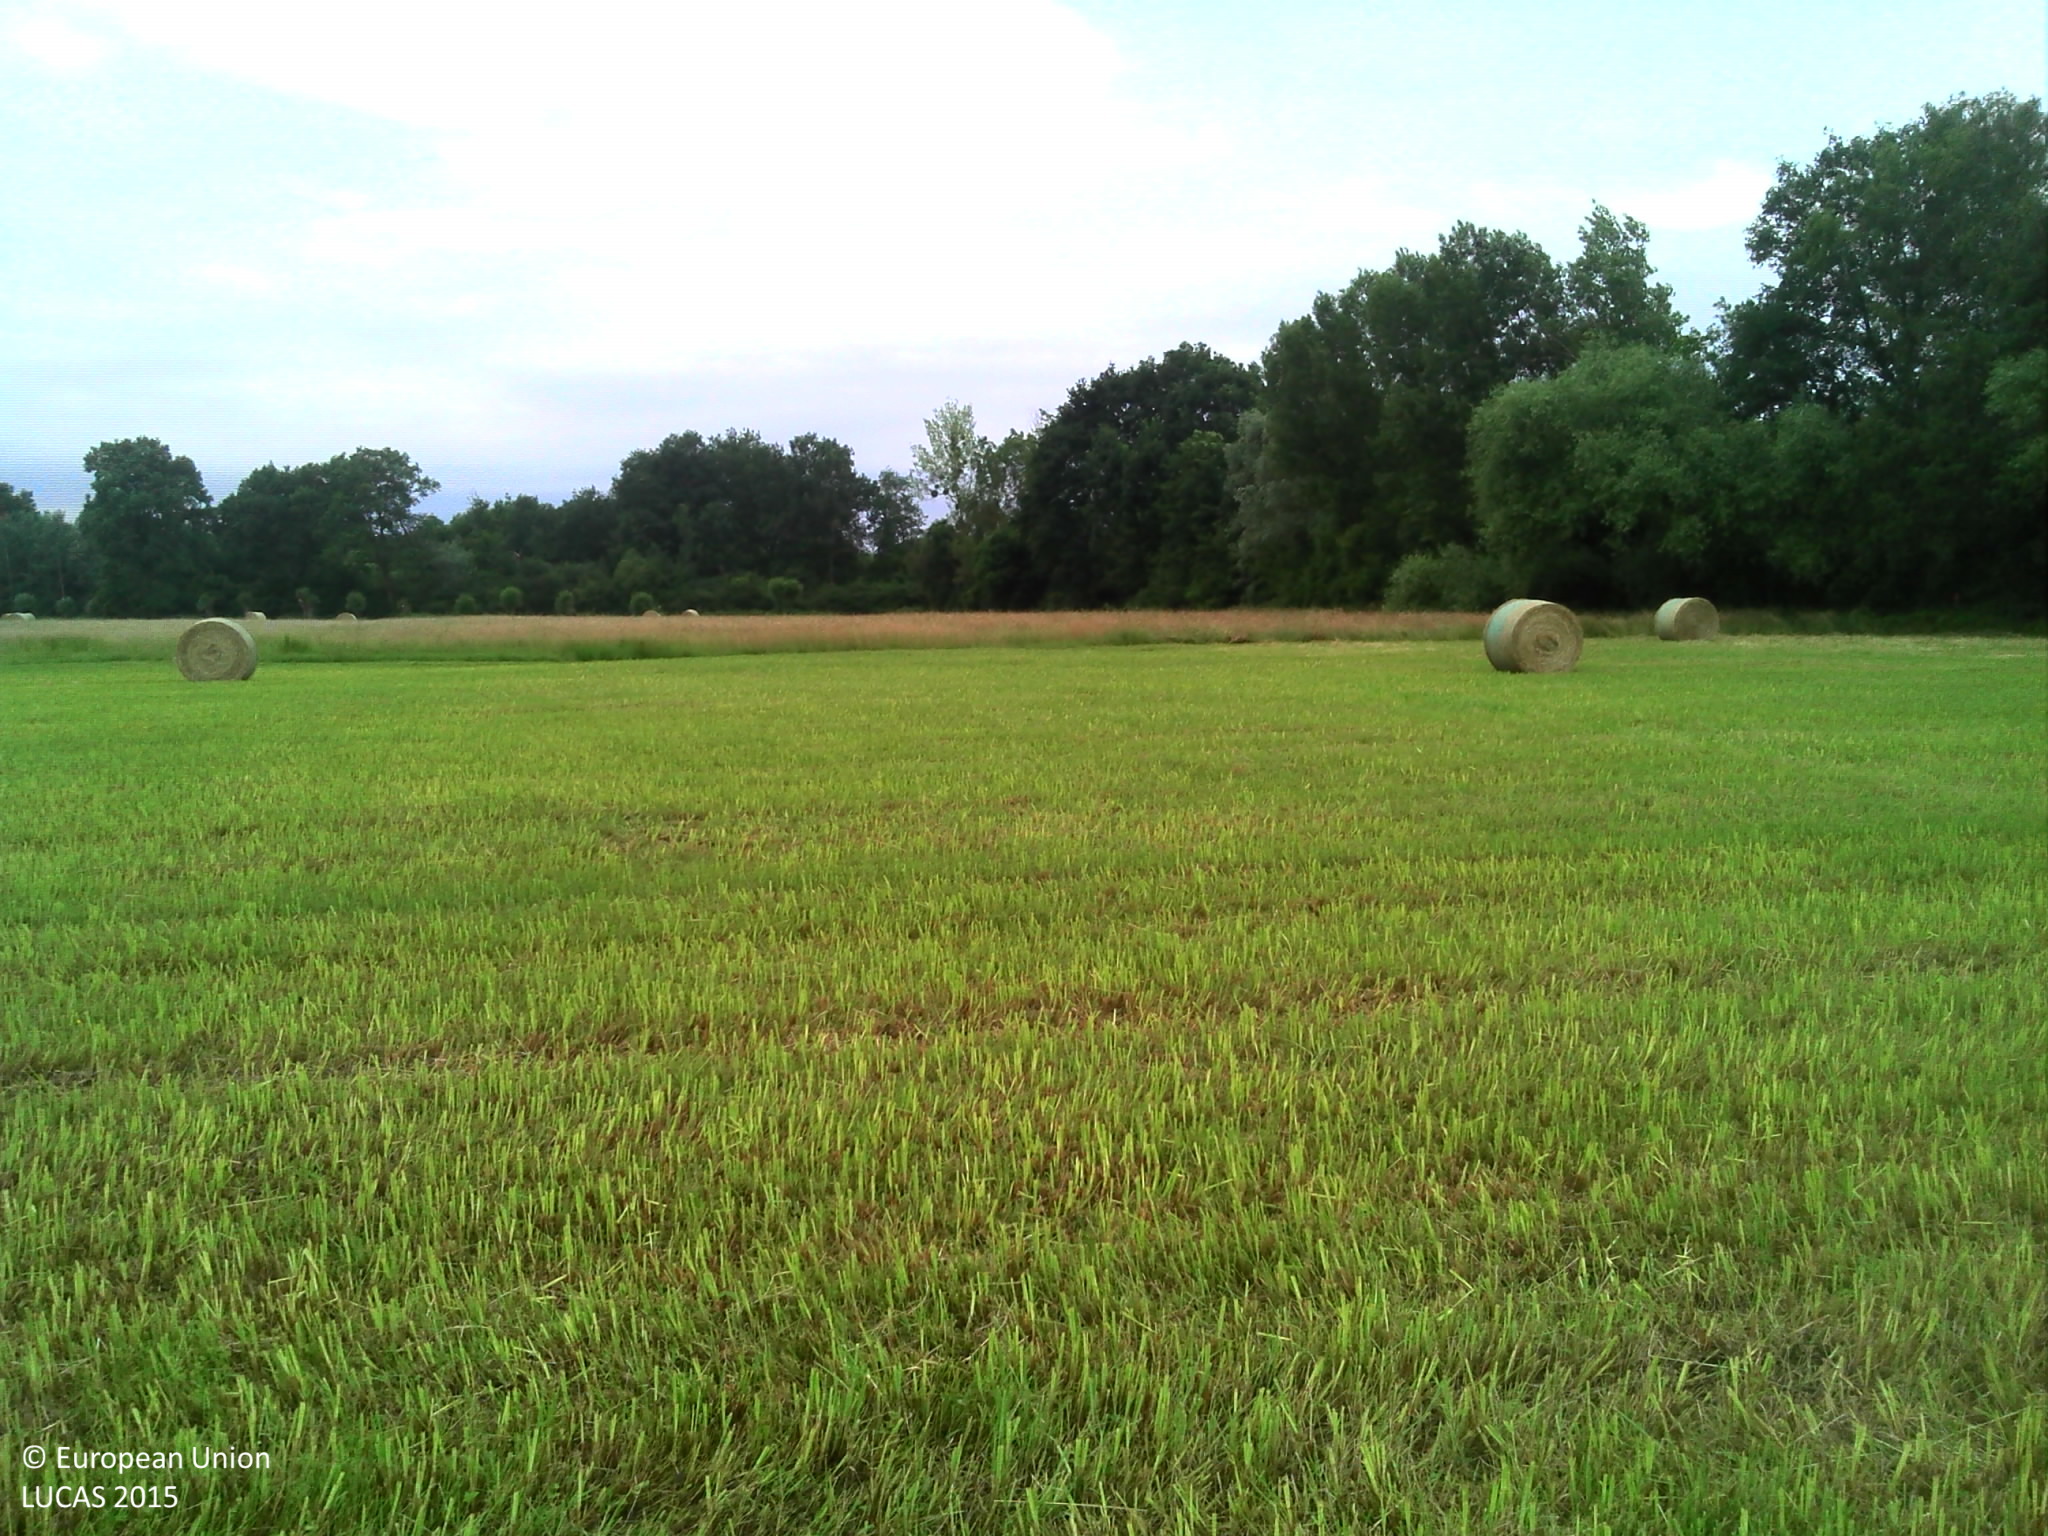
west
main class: Grassland
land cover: Grassland without tree/shrub cover
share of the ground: > 75 %
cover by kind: herbaceous plants 100 %
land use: Agriculture (excluding fallow land and kitchen gardens)
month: June
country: FR
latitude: 48.4856
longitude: 7.6061
